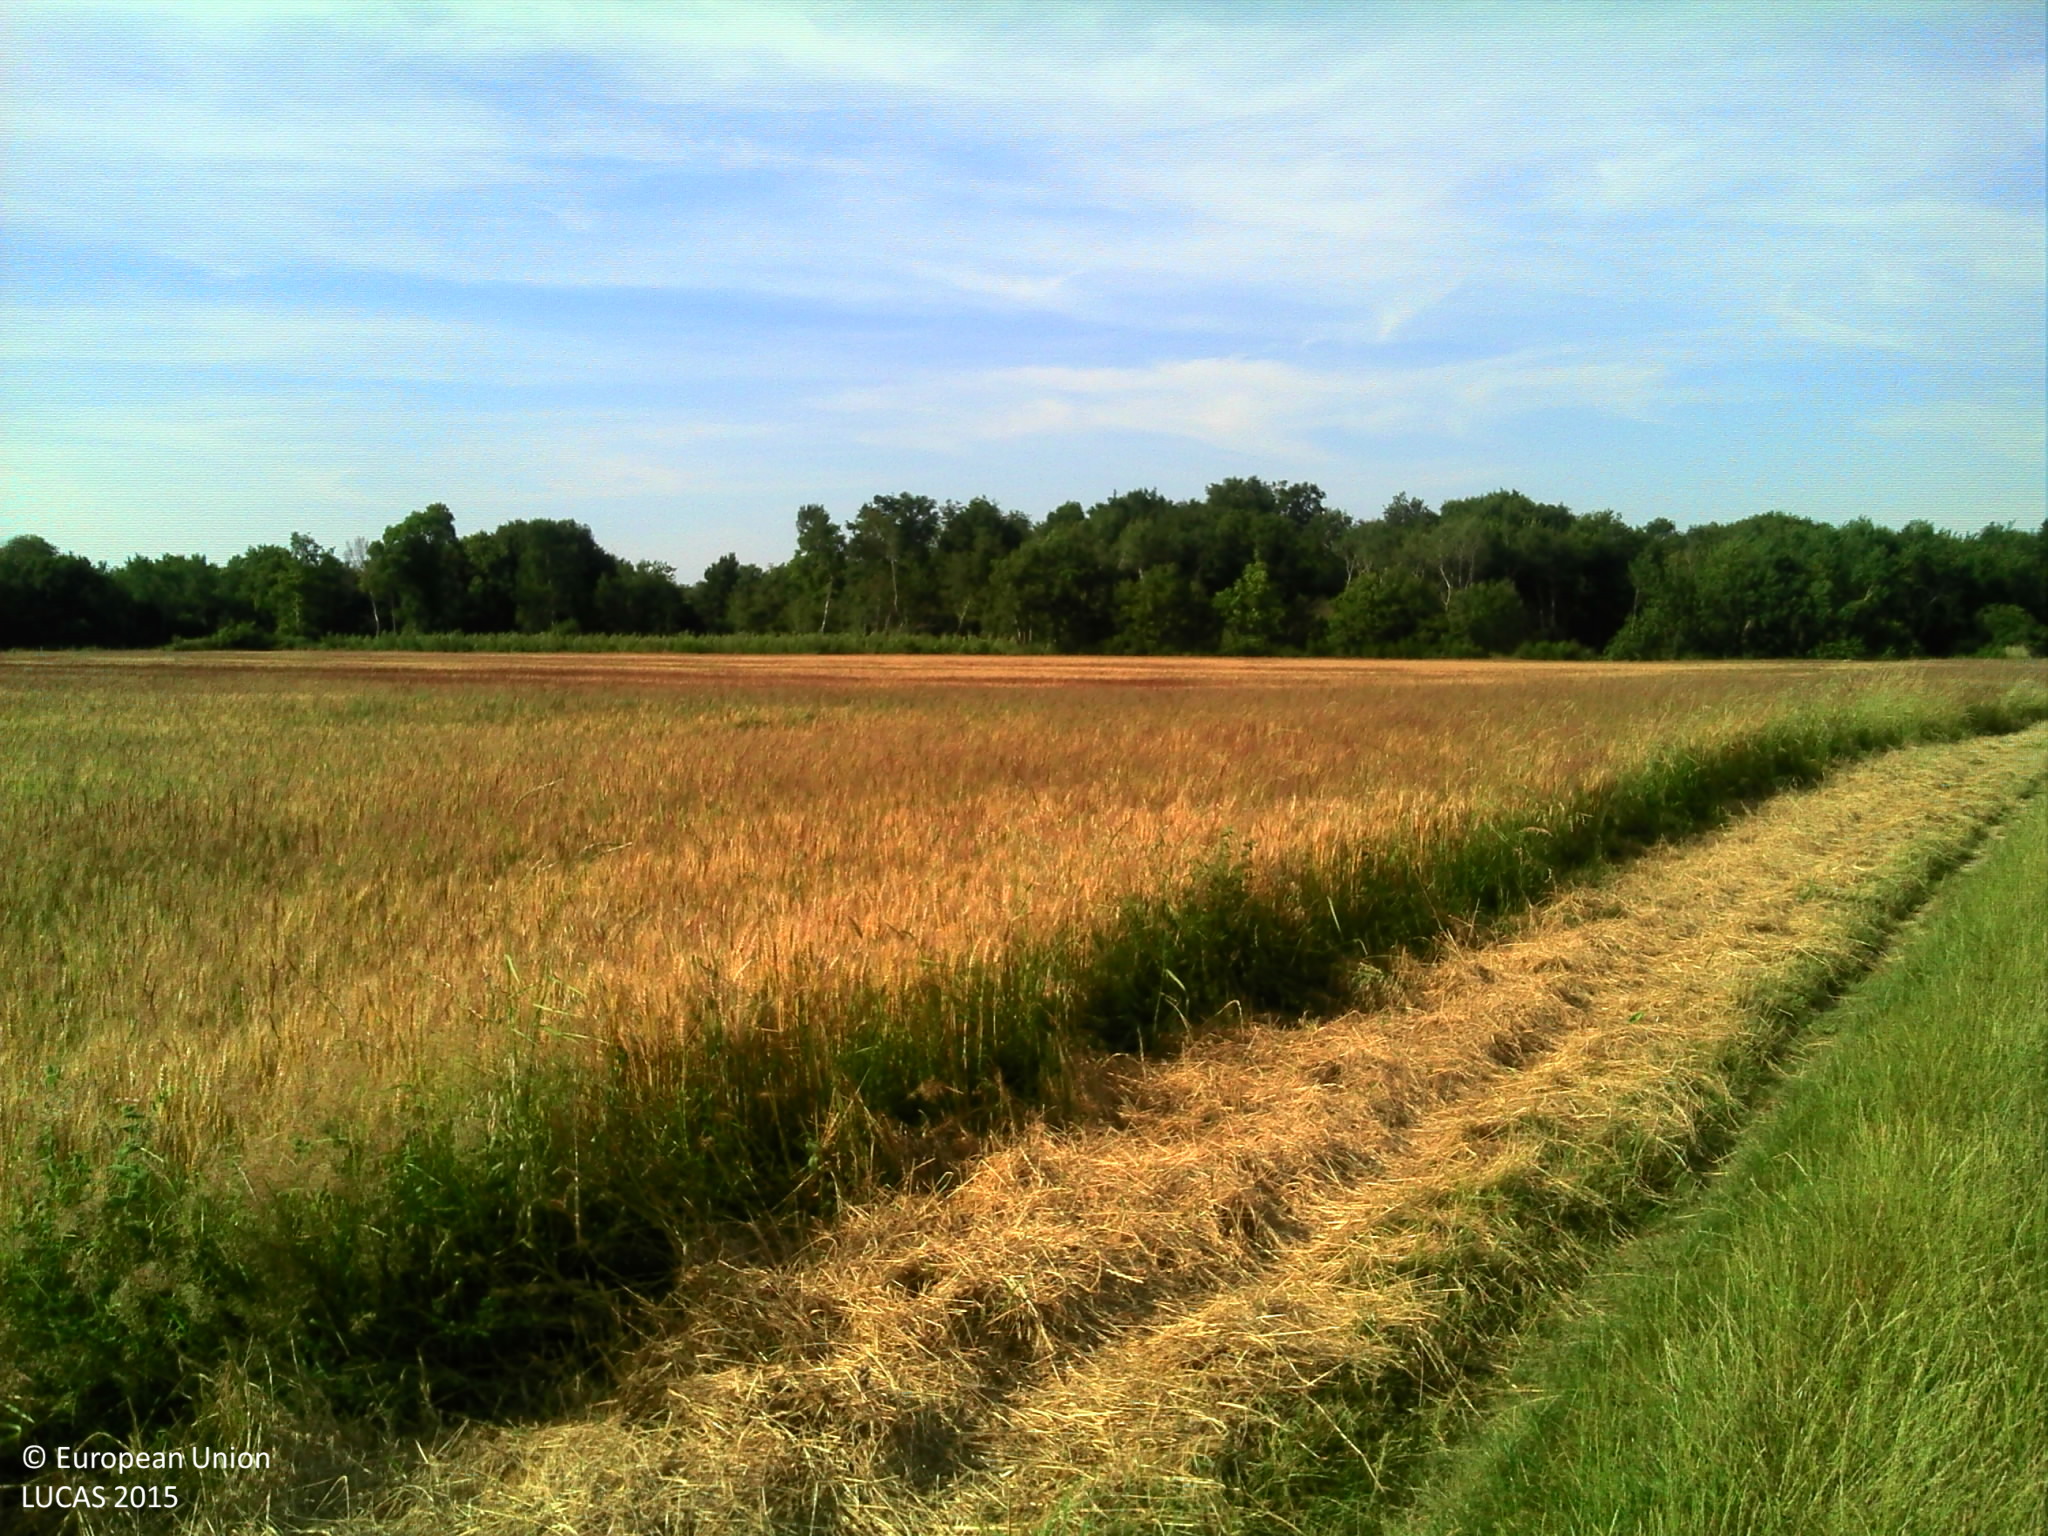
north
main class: Artificial land
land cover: Non built-up linear features
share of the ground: > 75 %
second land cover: Grassland without tree/shrub cover
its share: > 75 %
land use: Road transport
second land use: Agriculture (excluding fallow land and kitchen gardens)
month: June
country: FR
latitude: 45.8335
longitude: -0.8538
